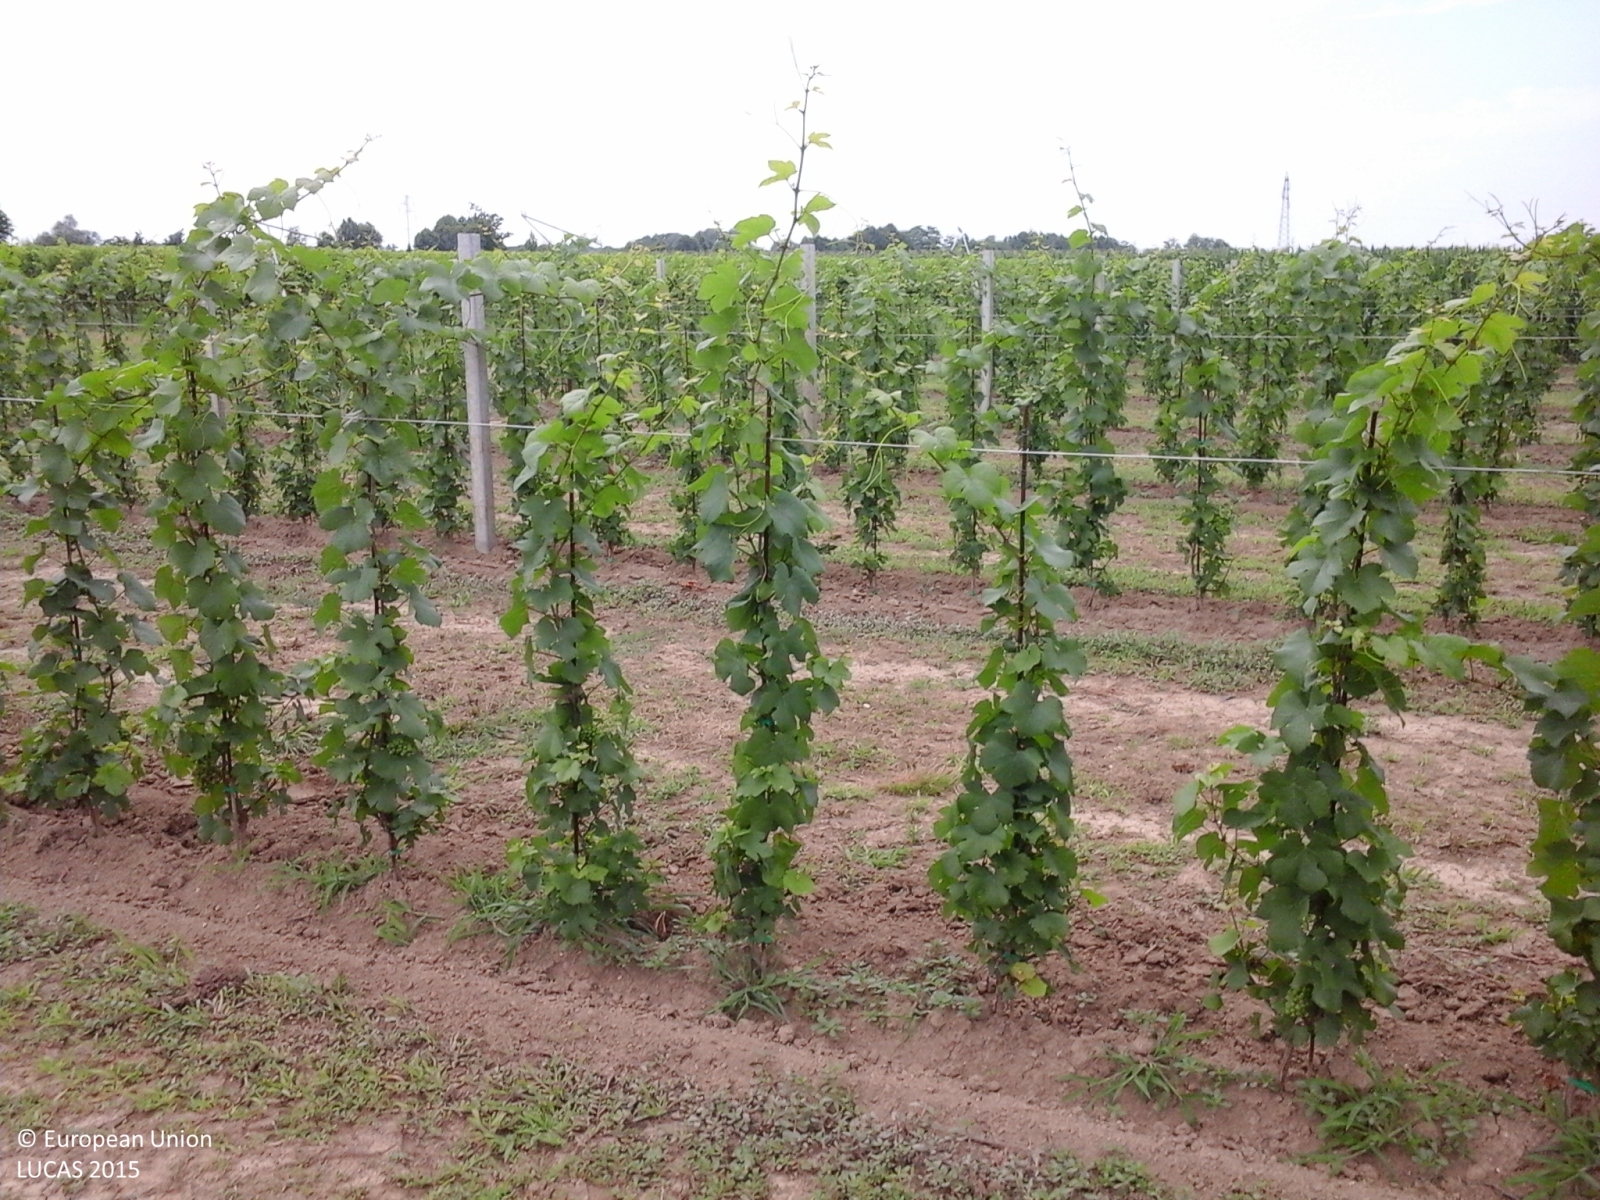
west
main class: Cropland
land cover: Vineyards
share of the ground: 50 - 75 %
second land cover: Grassland without tree/shrub cover
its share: 50 - 75 %
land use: Agriculture (excluding fallow land and kitchen gardens)
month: June
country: IT
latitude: 45.7656
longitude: 12.4011
